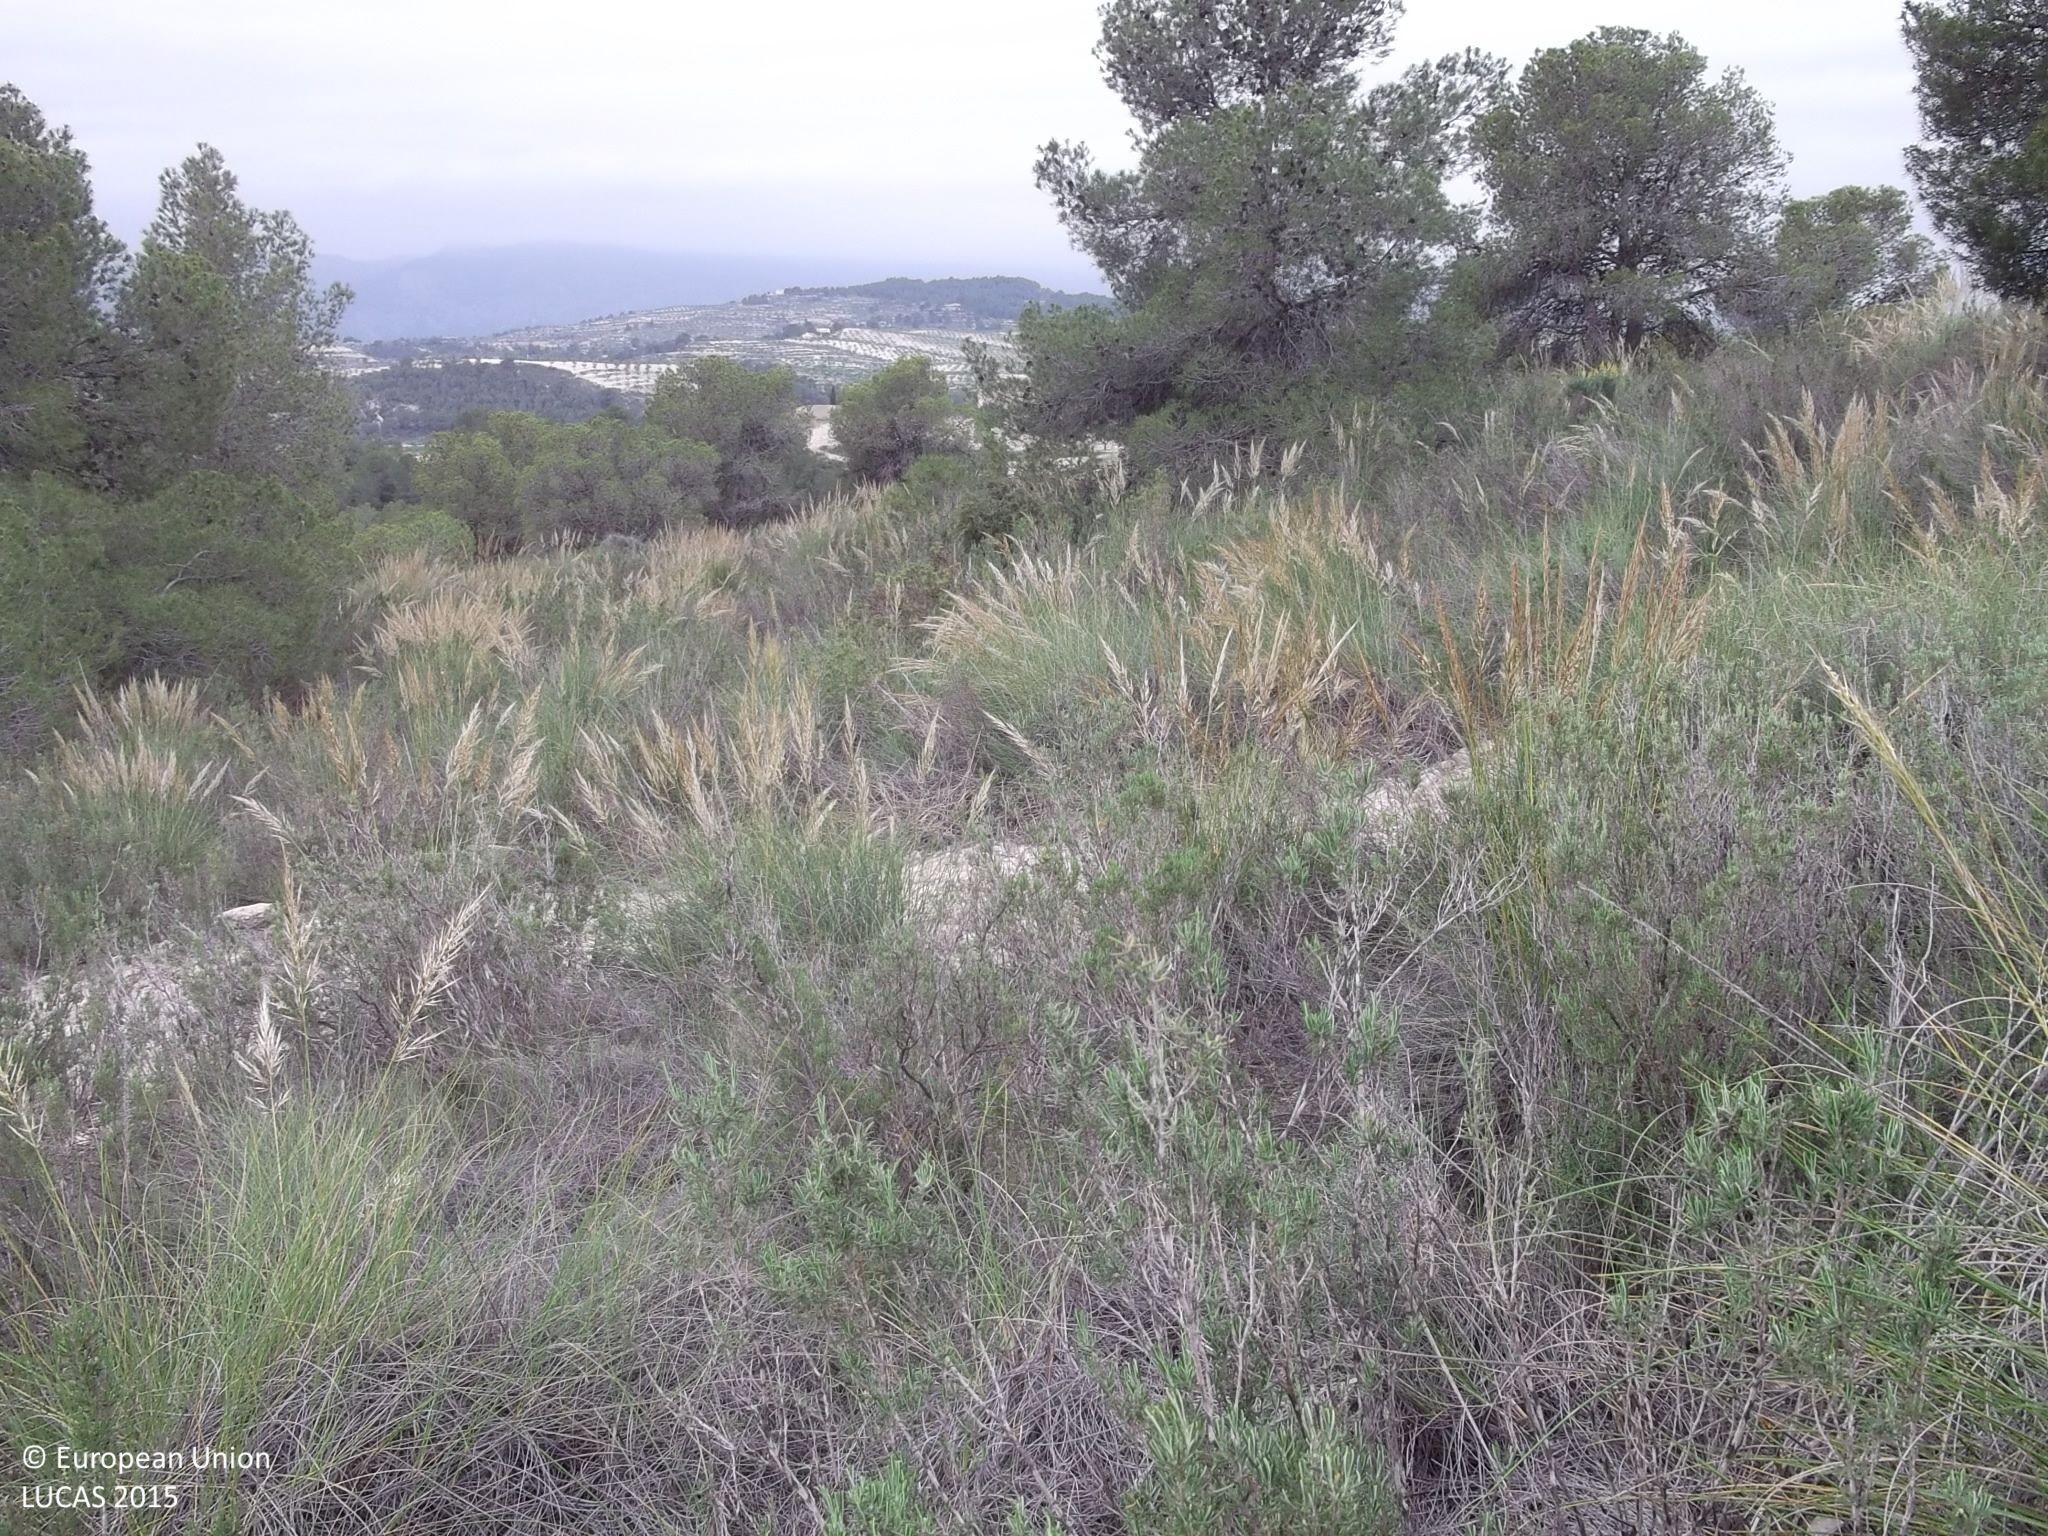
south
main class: Shrubland
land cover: Shrubland without tree cover
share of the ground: 25 - 50 %
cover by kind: herbaceous plants 60 %, shrubs 40 %
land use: Semi-natural and natural areas not in use
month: April
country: ES
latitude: 38.0266
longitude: -1.5723
